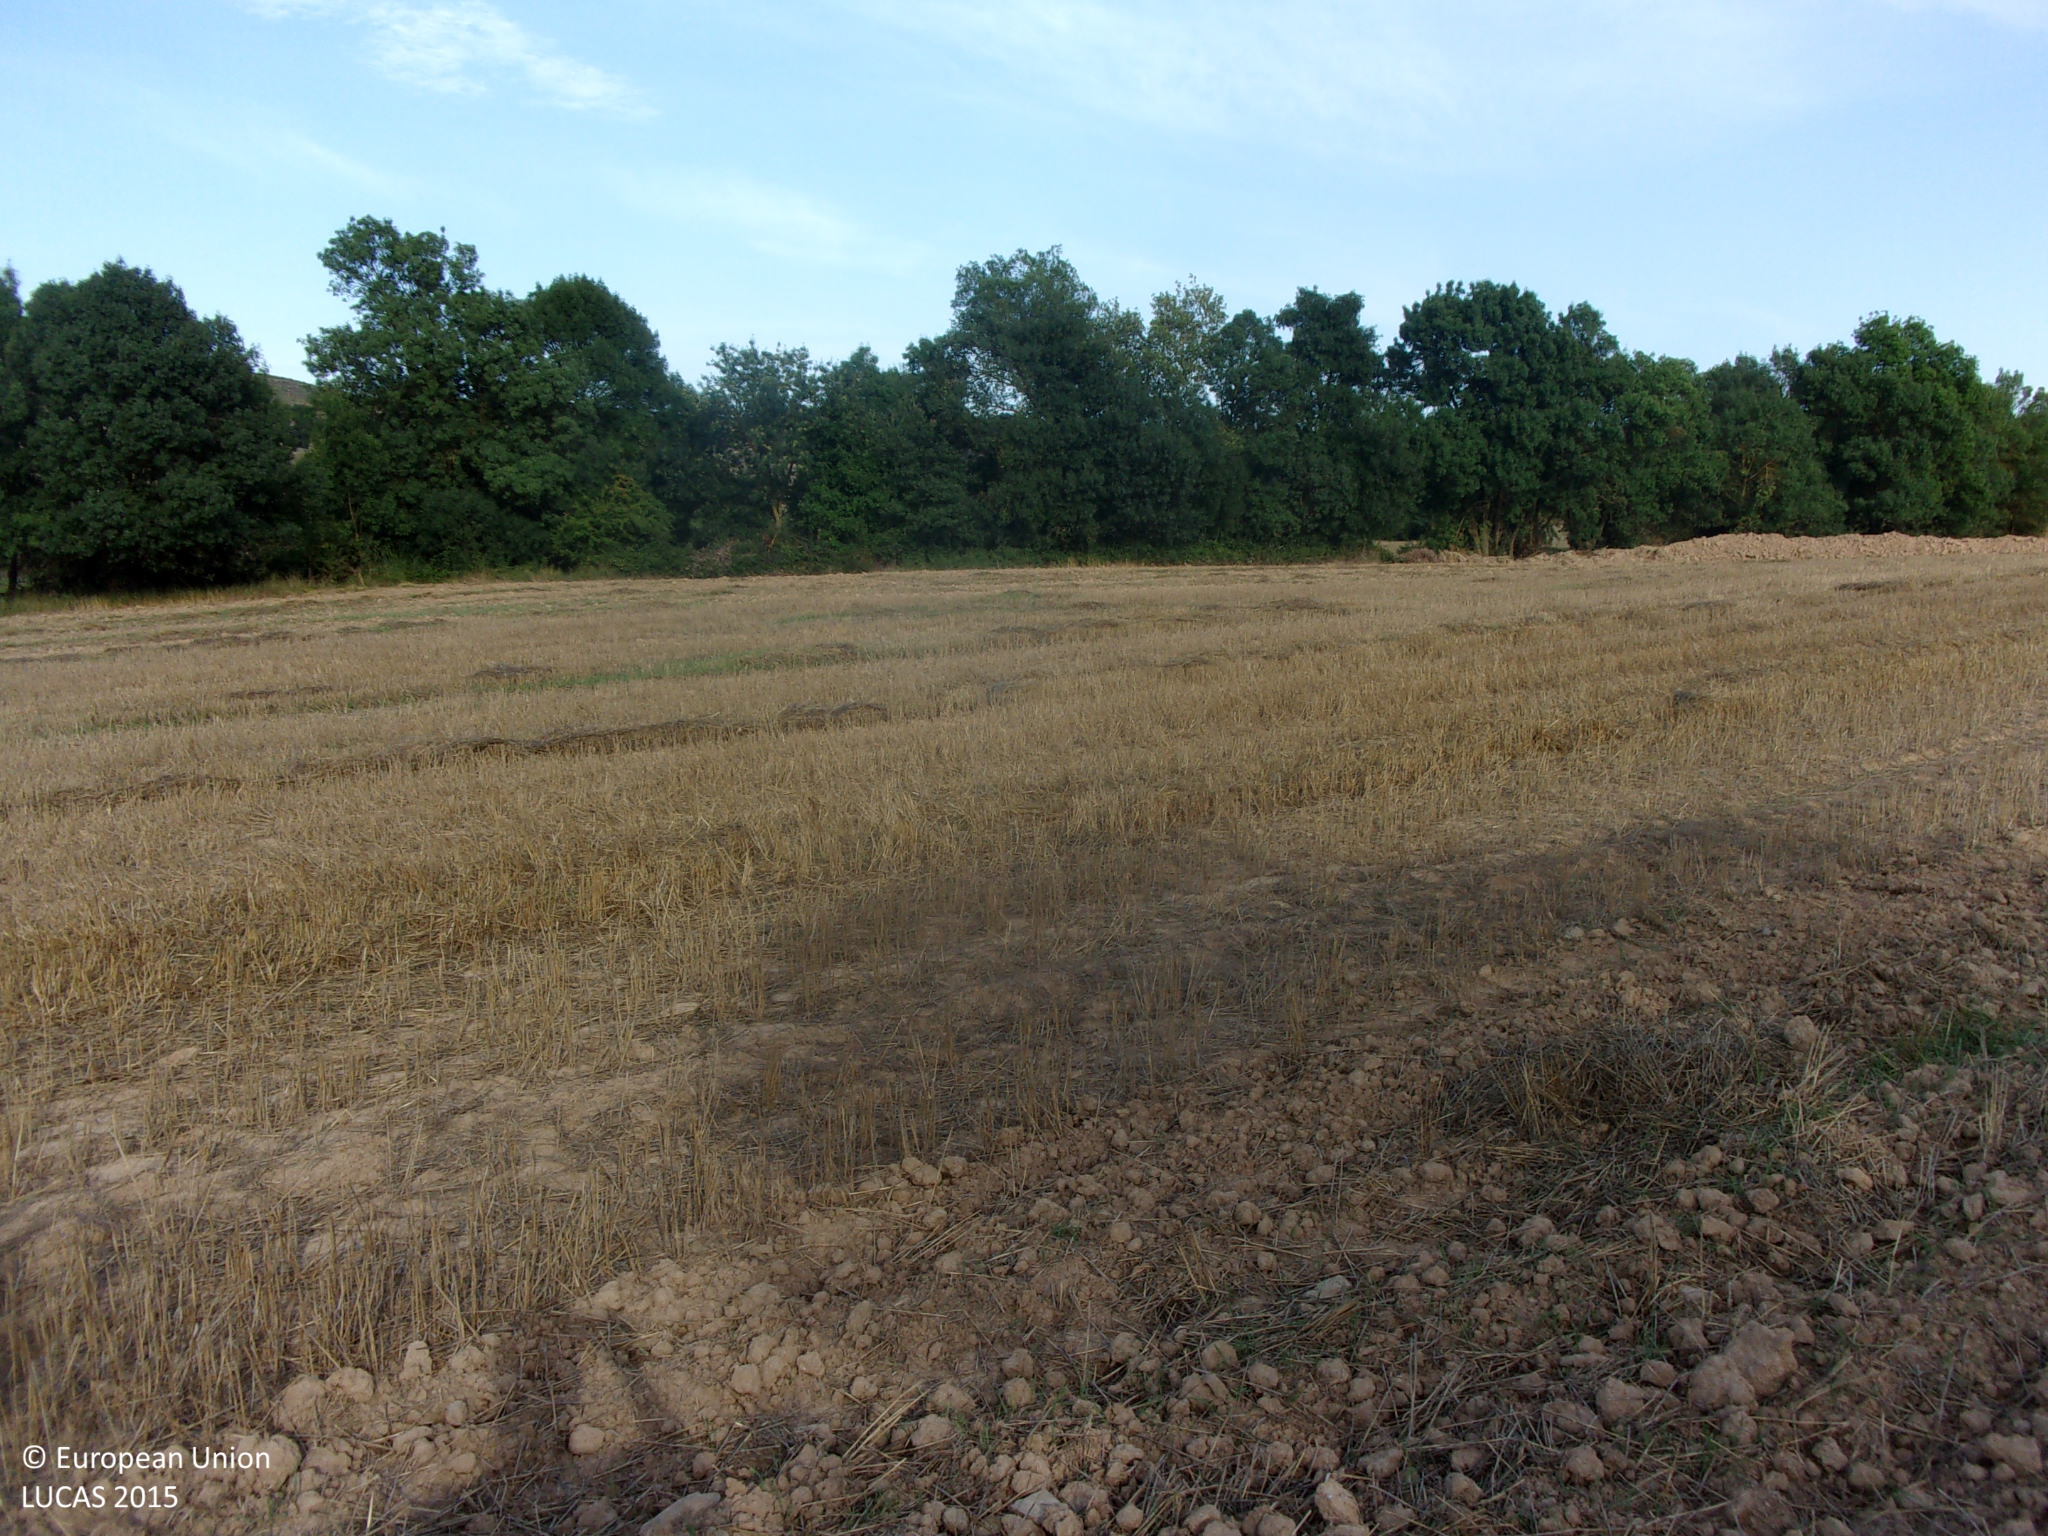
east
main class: Cropland
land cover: Common wheat
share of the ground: < 10 %
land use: Agriculture (excluding fallow land and kitchen gardens)
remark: Harvested field
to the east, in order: Common wheat; Other mixed woodland; Barley; Other mixed woodland; Barley
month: August
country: ES
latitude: 42.4955
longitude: -1.1160
